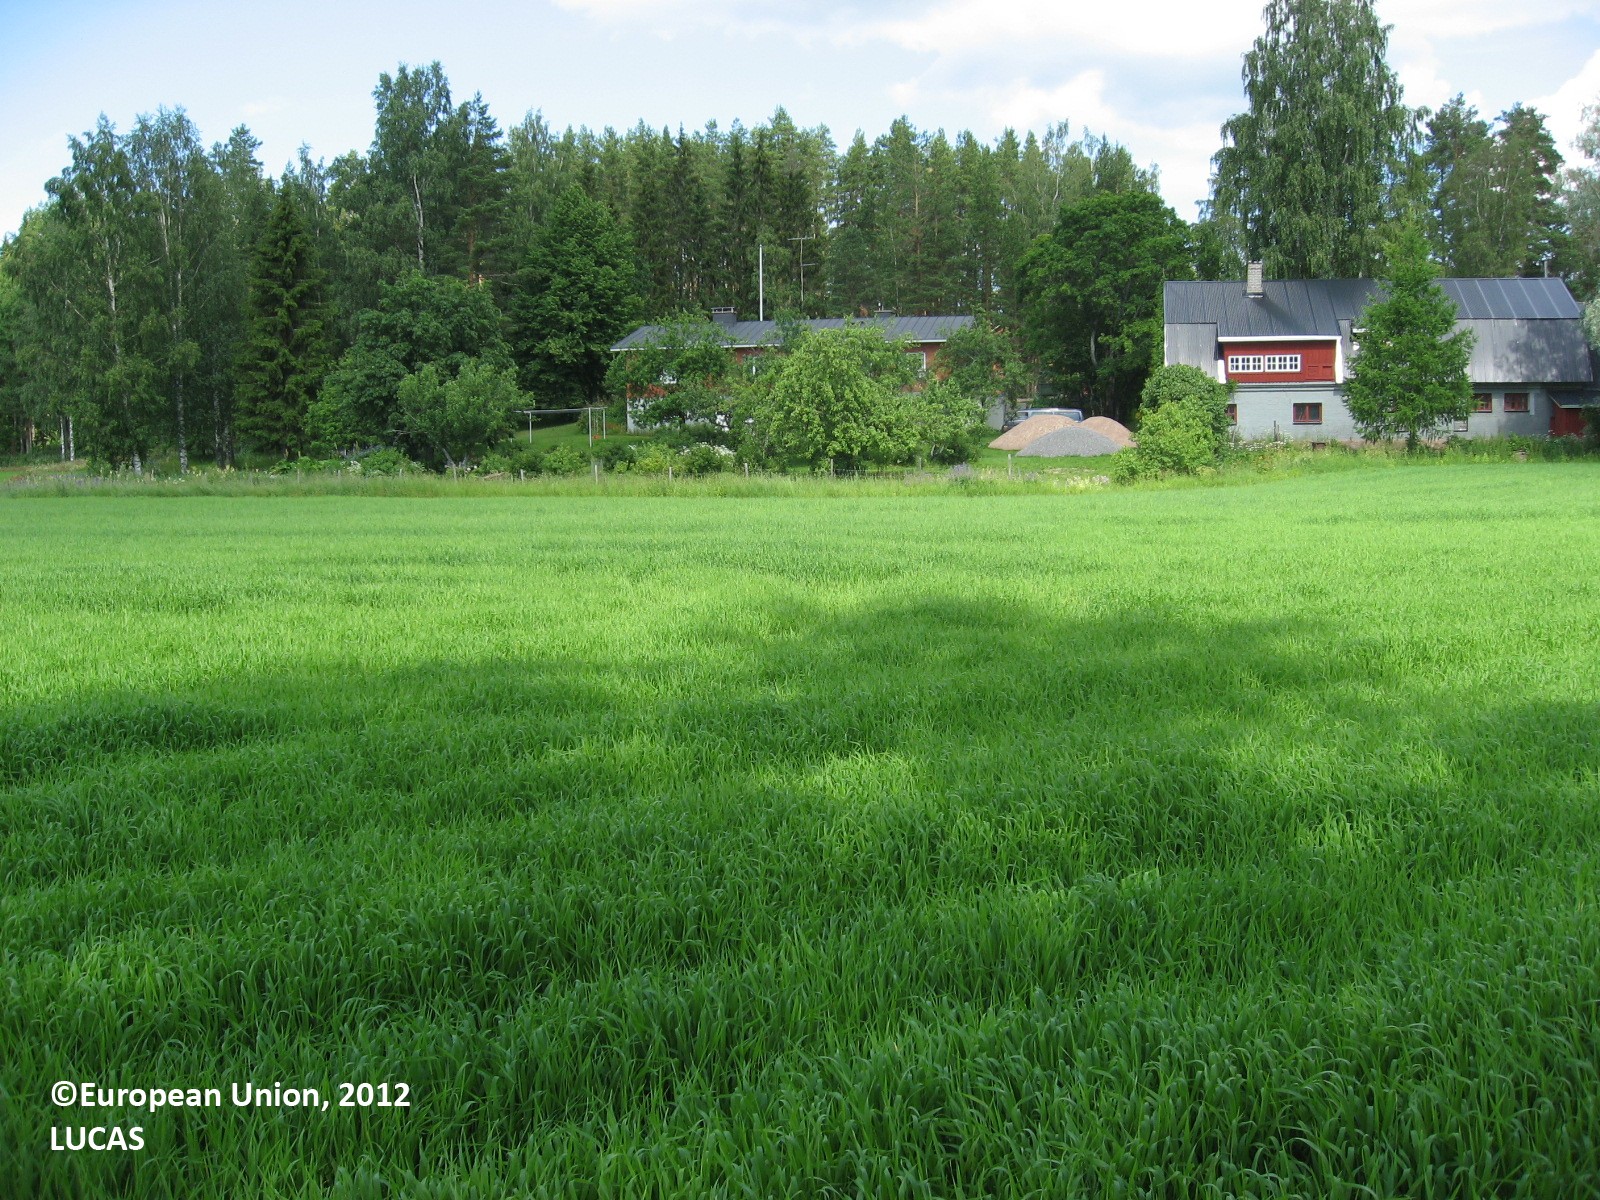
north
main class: Cropland
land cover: Barley
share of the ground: > 75 %
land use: Agriculture (excluding fallow land and kitchen gardens)
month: July
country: FI
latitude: 60.9275
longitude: 26.5551
